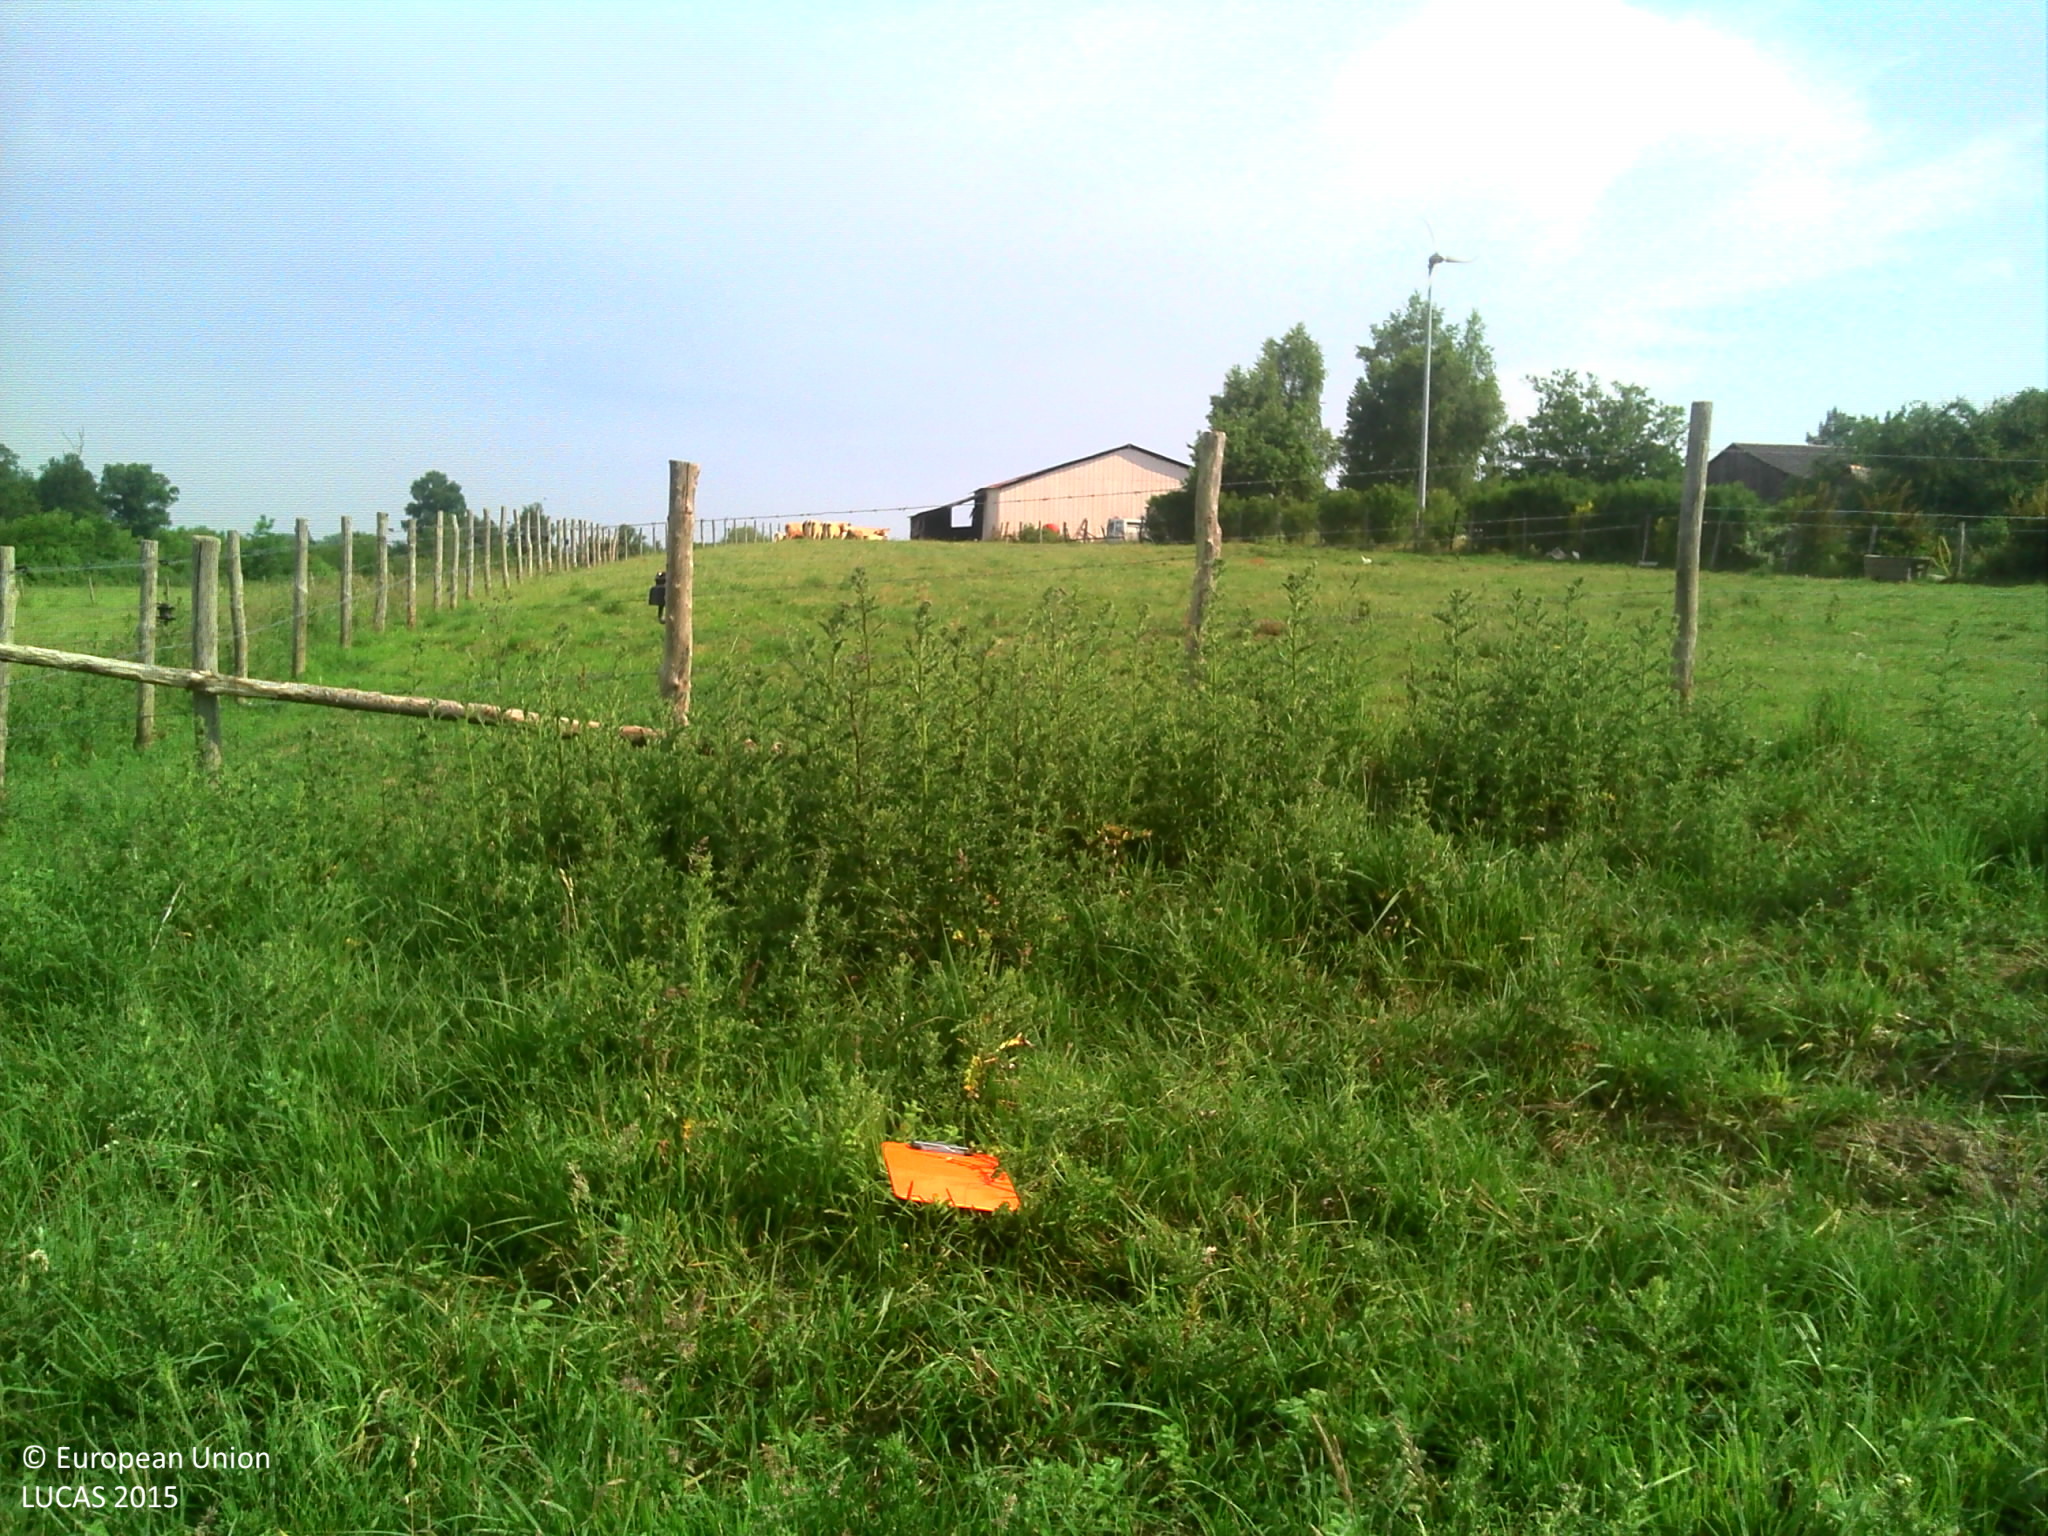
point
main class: Grassland
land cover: Grassland without tree/shrub cover
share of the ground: > 75 %
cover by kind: herbaceous plants 100 %
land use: Agriculture (excluding fallow land and kitchen gardens)
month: June
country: FR
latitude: 47.8929
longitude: -0.0189
